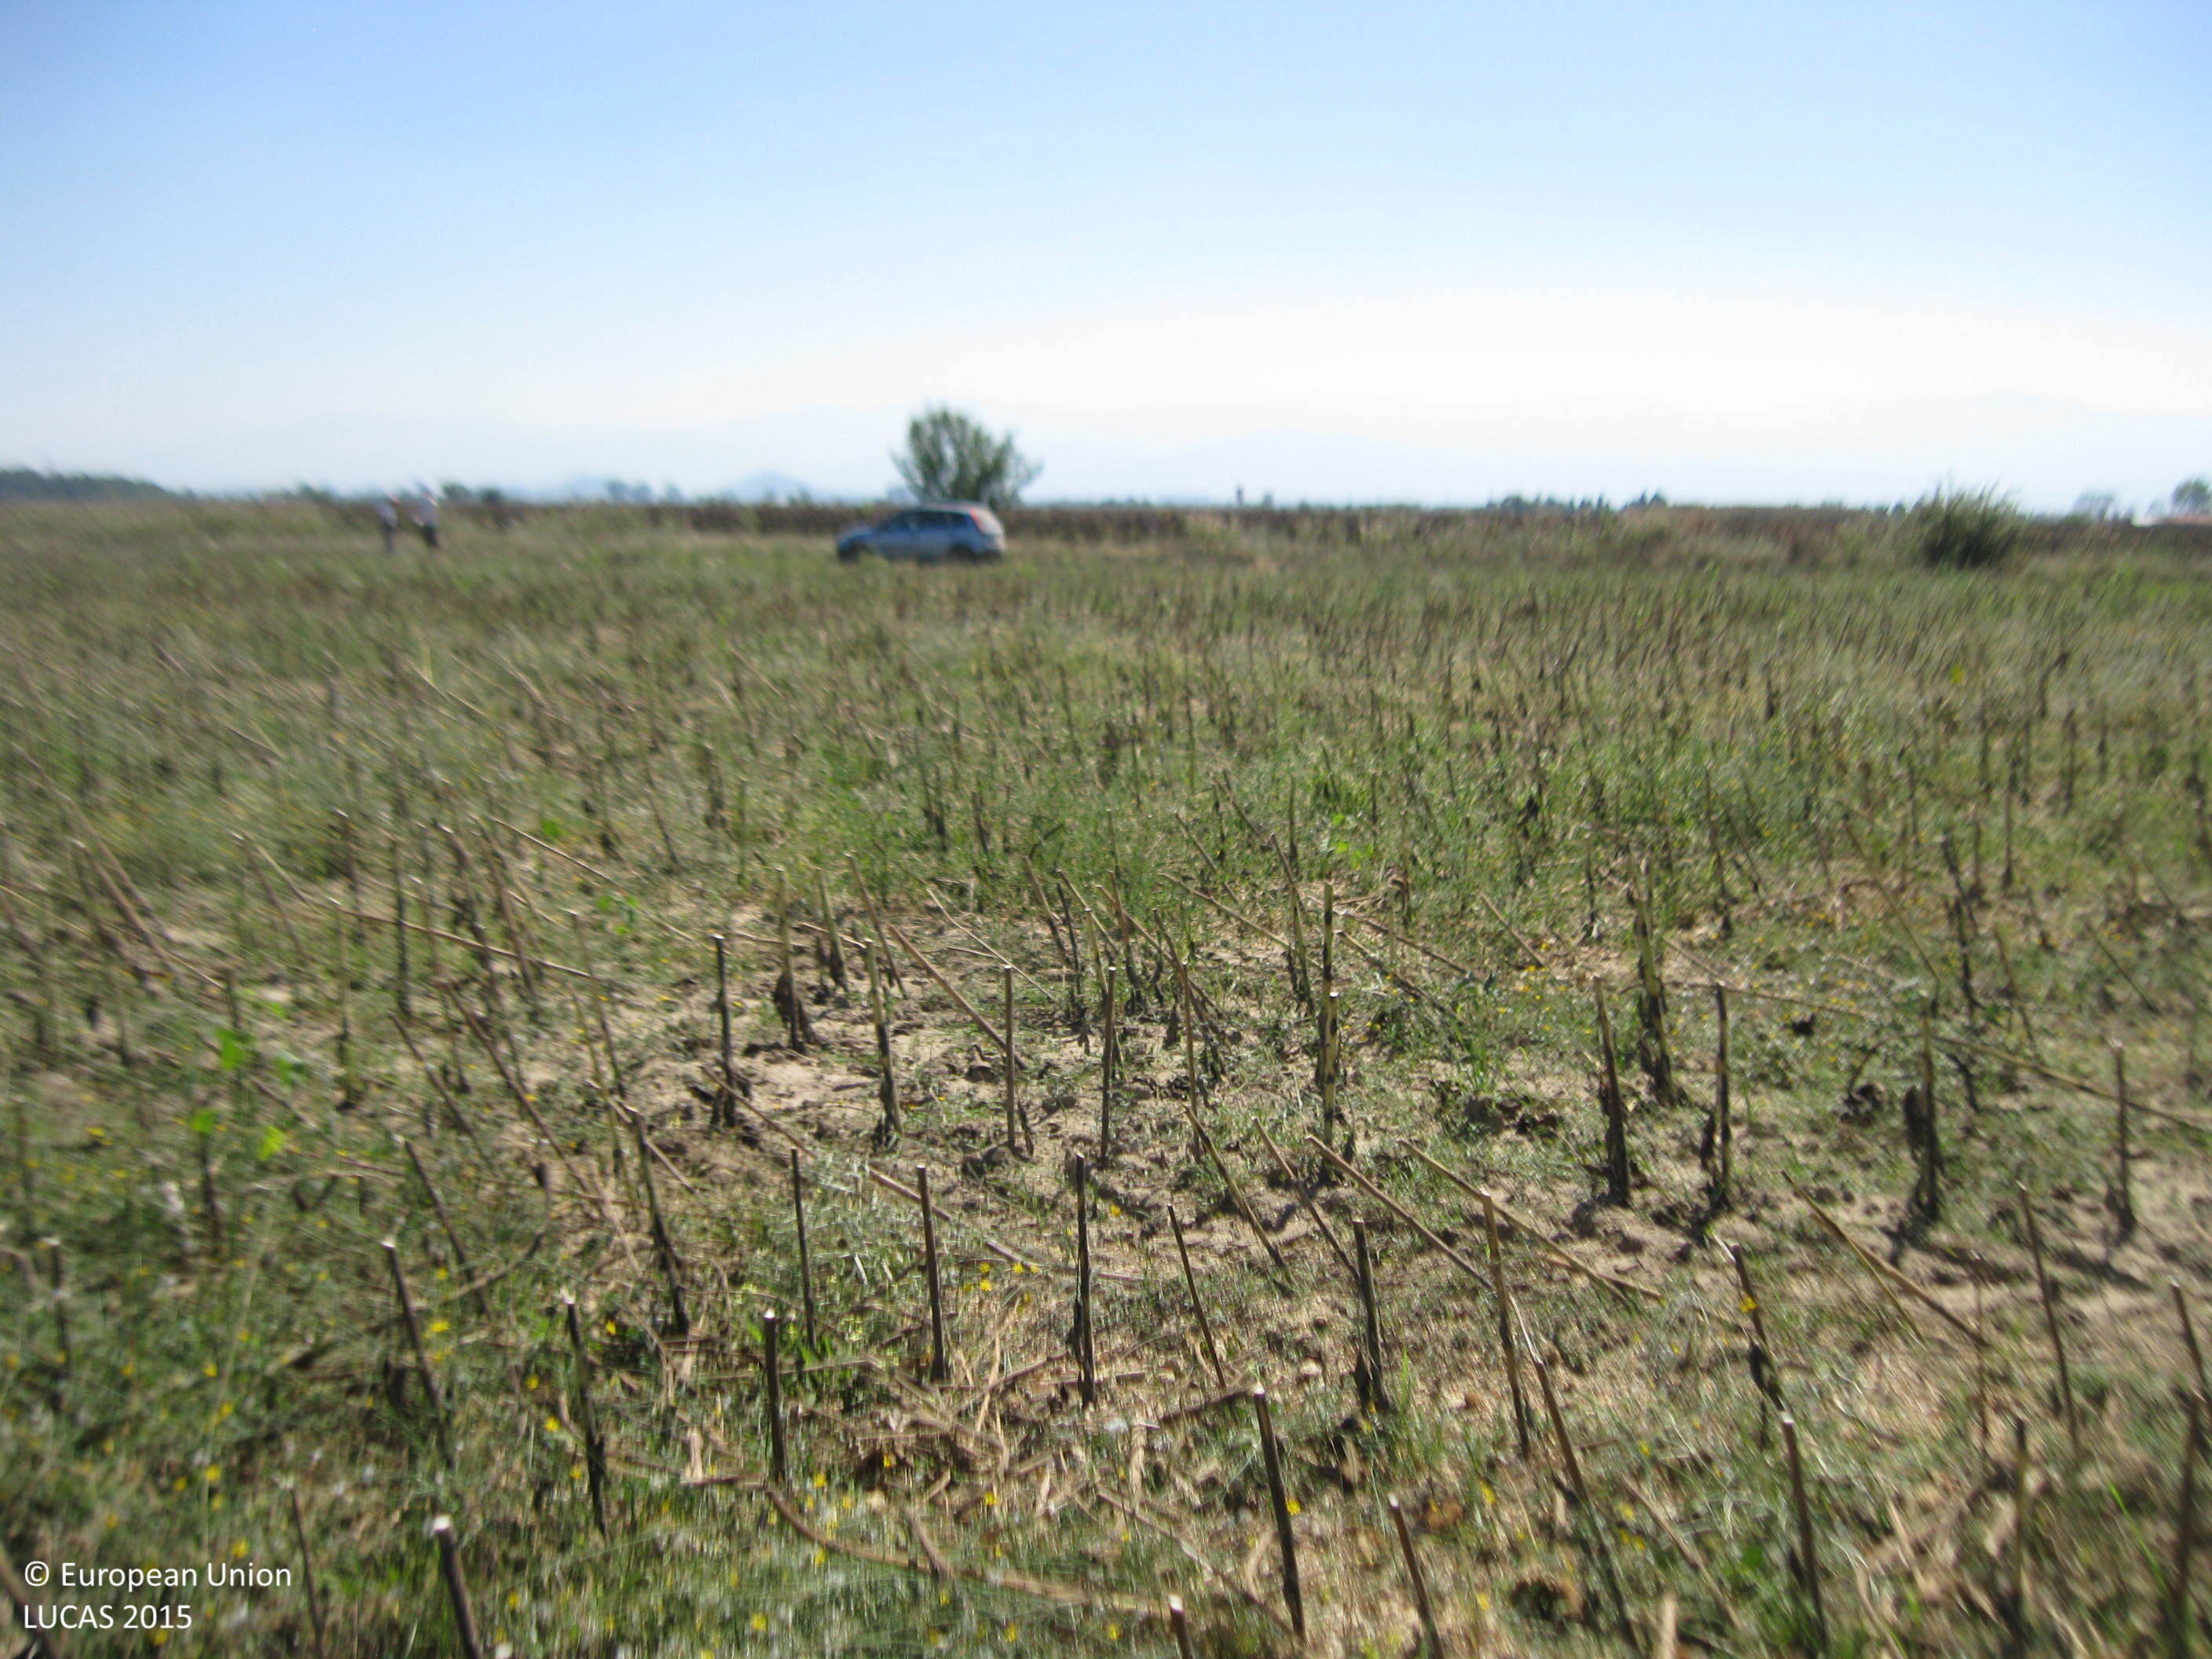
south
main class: Cropland
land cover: Sunflower
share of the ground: < 10 %
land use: Agriculture (excluding fallow land and kitchen gardens)
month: September
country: BG
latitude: 42.2166
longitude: 24.6971
